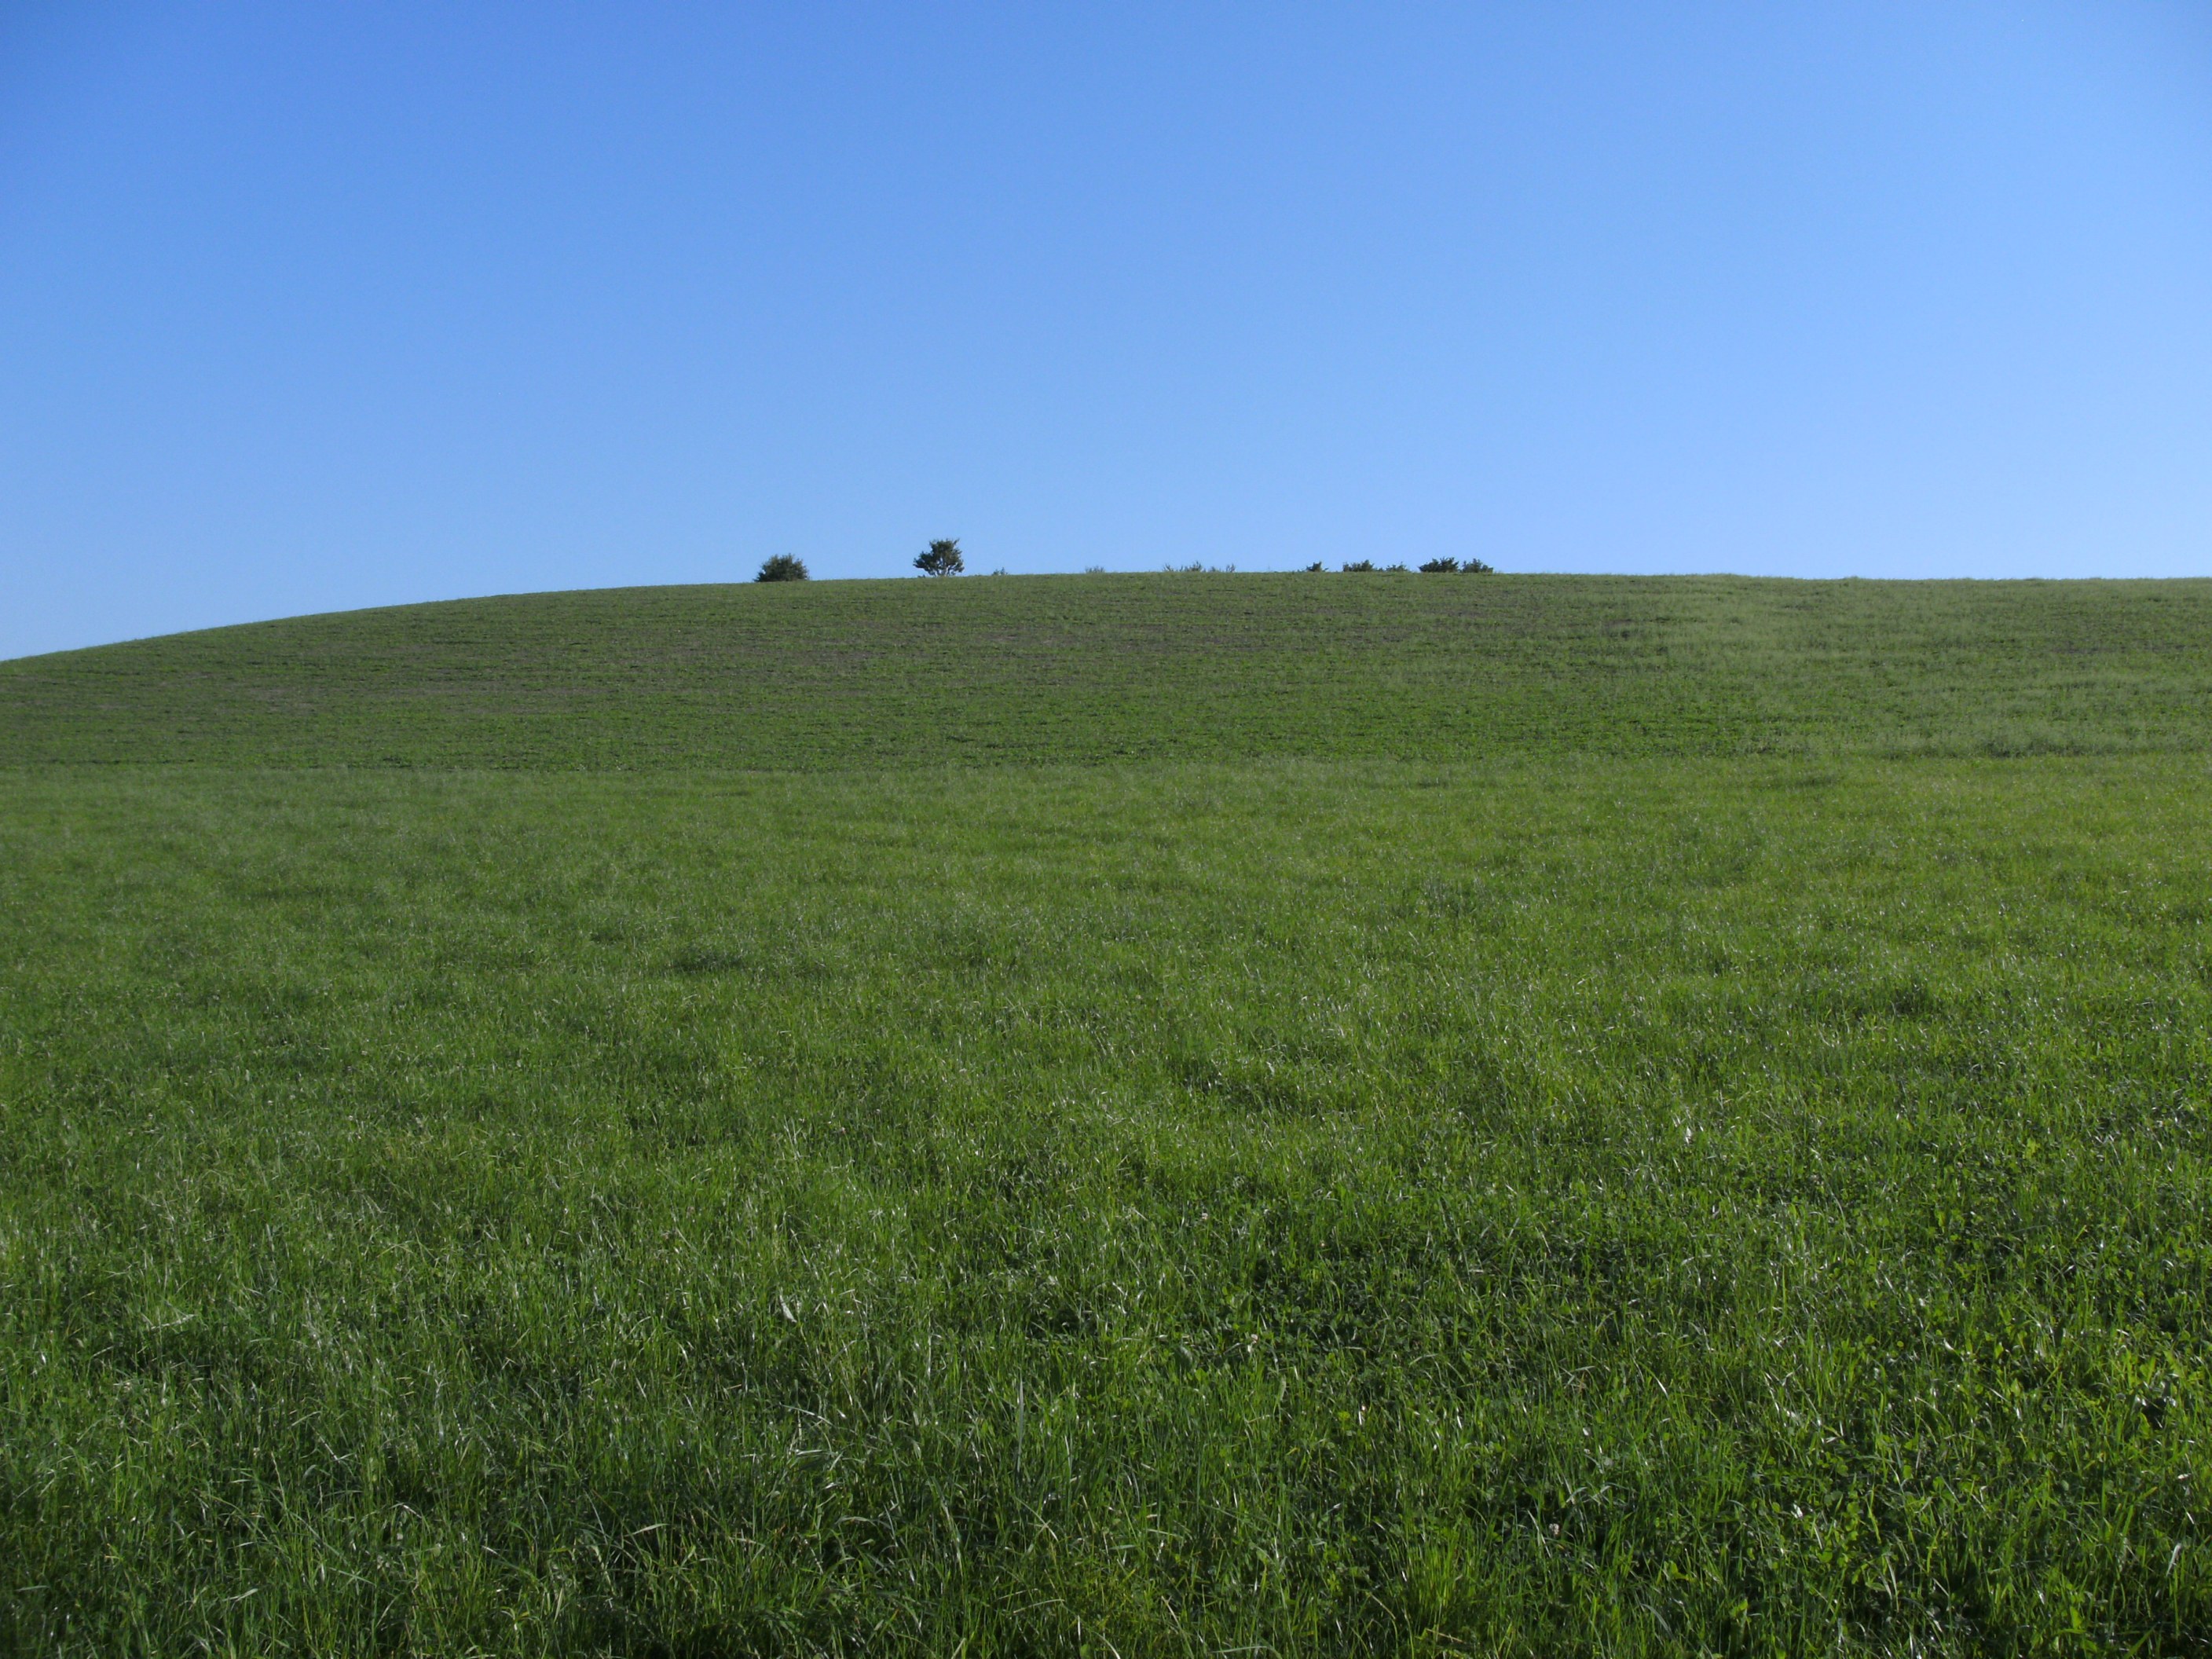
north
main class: Grassland
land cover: Grassland without tree/shrub cover
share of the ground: > 75 %
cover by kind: herbaceous plants 100 %
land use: Agriculture (excluding fallow land and kitchen gardens)
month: July
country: AT
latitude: 48.1677
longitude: 13.5087
